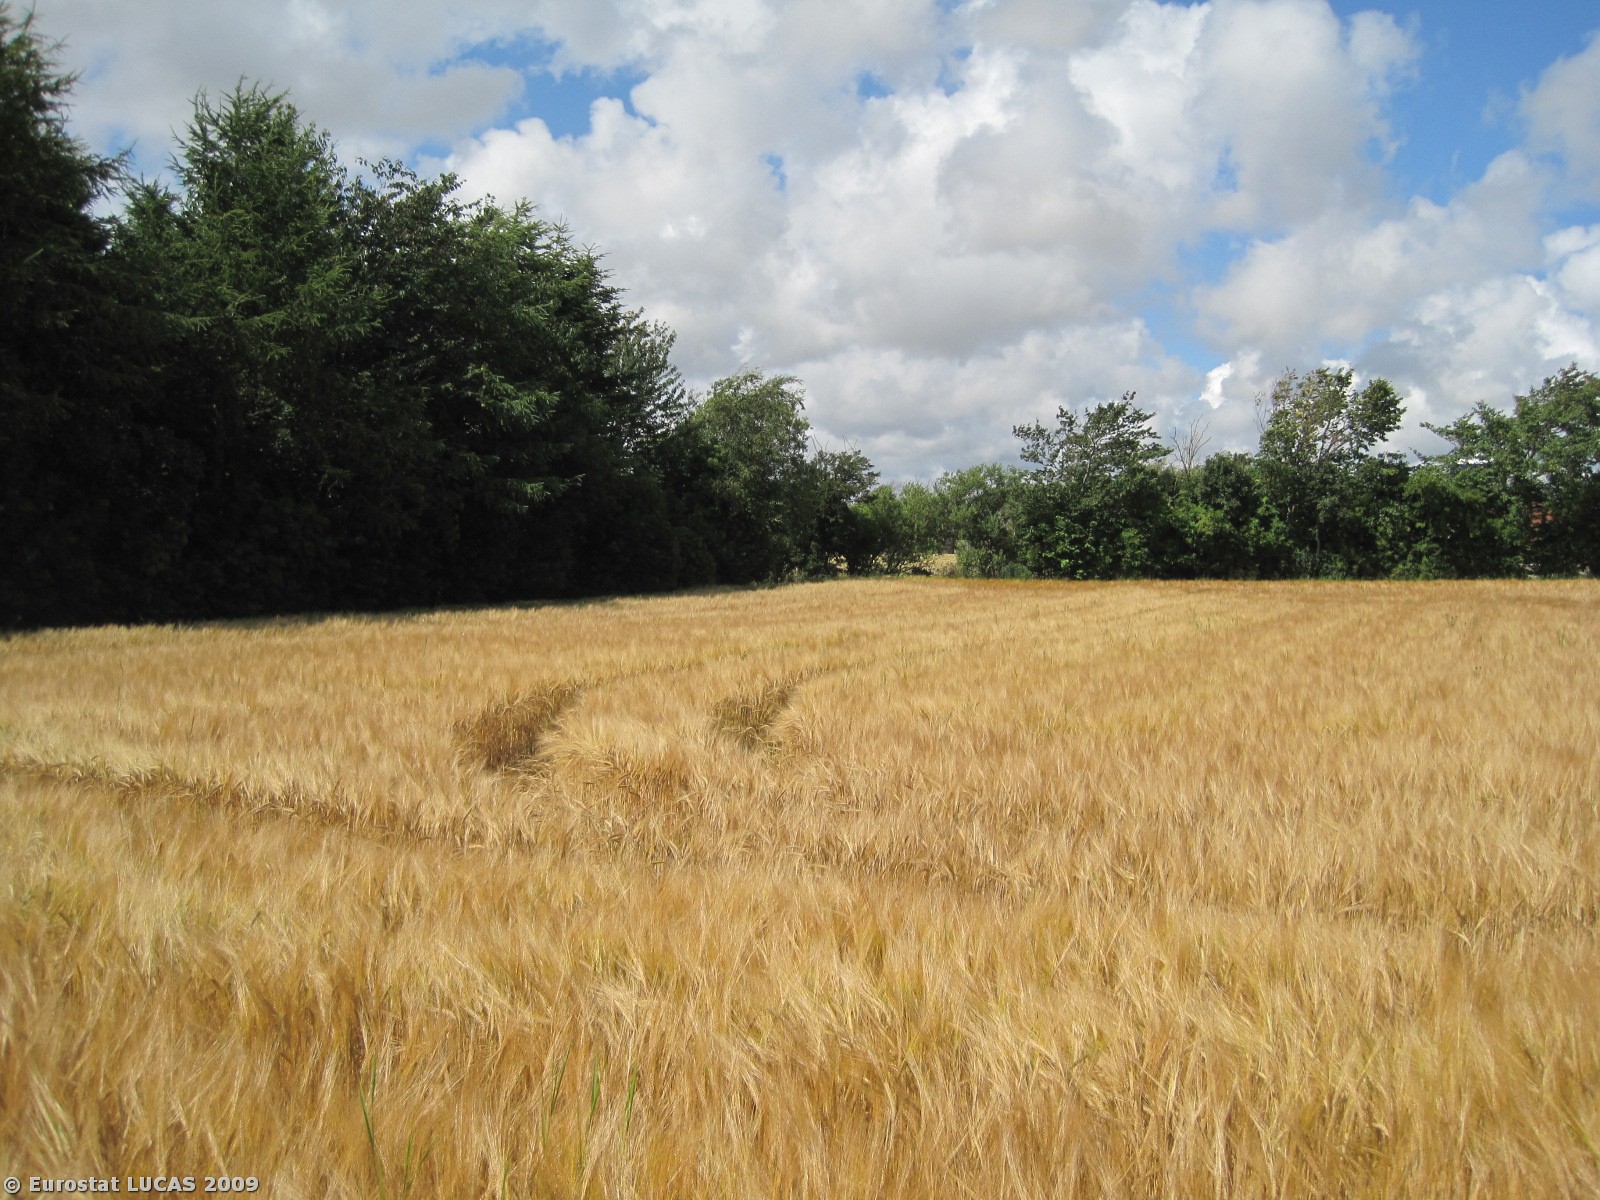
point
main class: Cropland
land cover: Barley
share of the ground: > 75 %
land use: Agriculture (excluding fallow land and kitchen gardens)
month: July
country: DK
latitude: 56.9726
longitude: 8.7351
